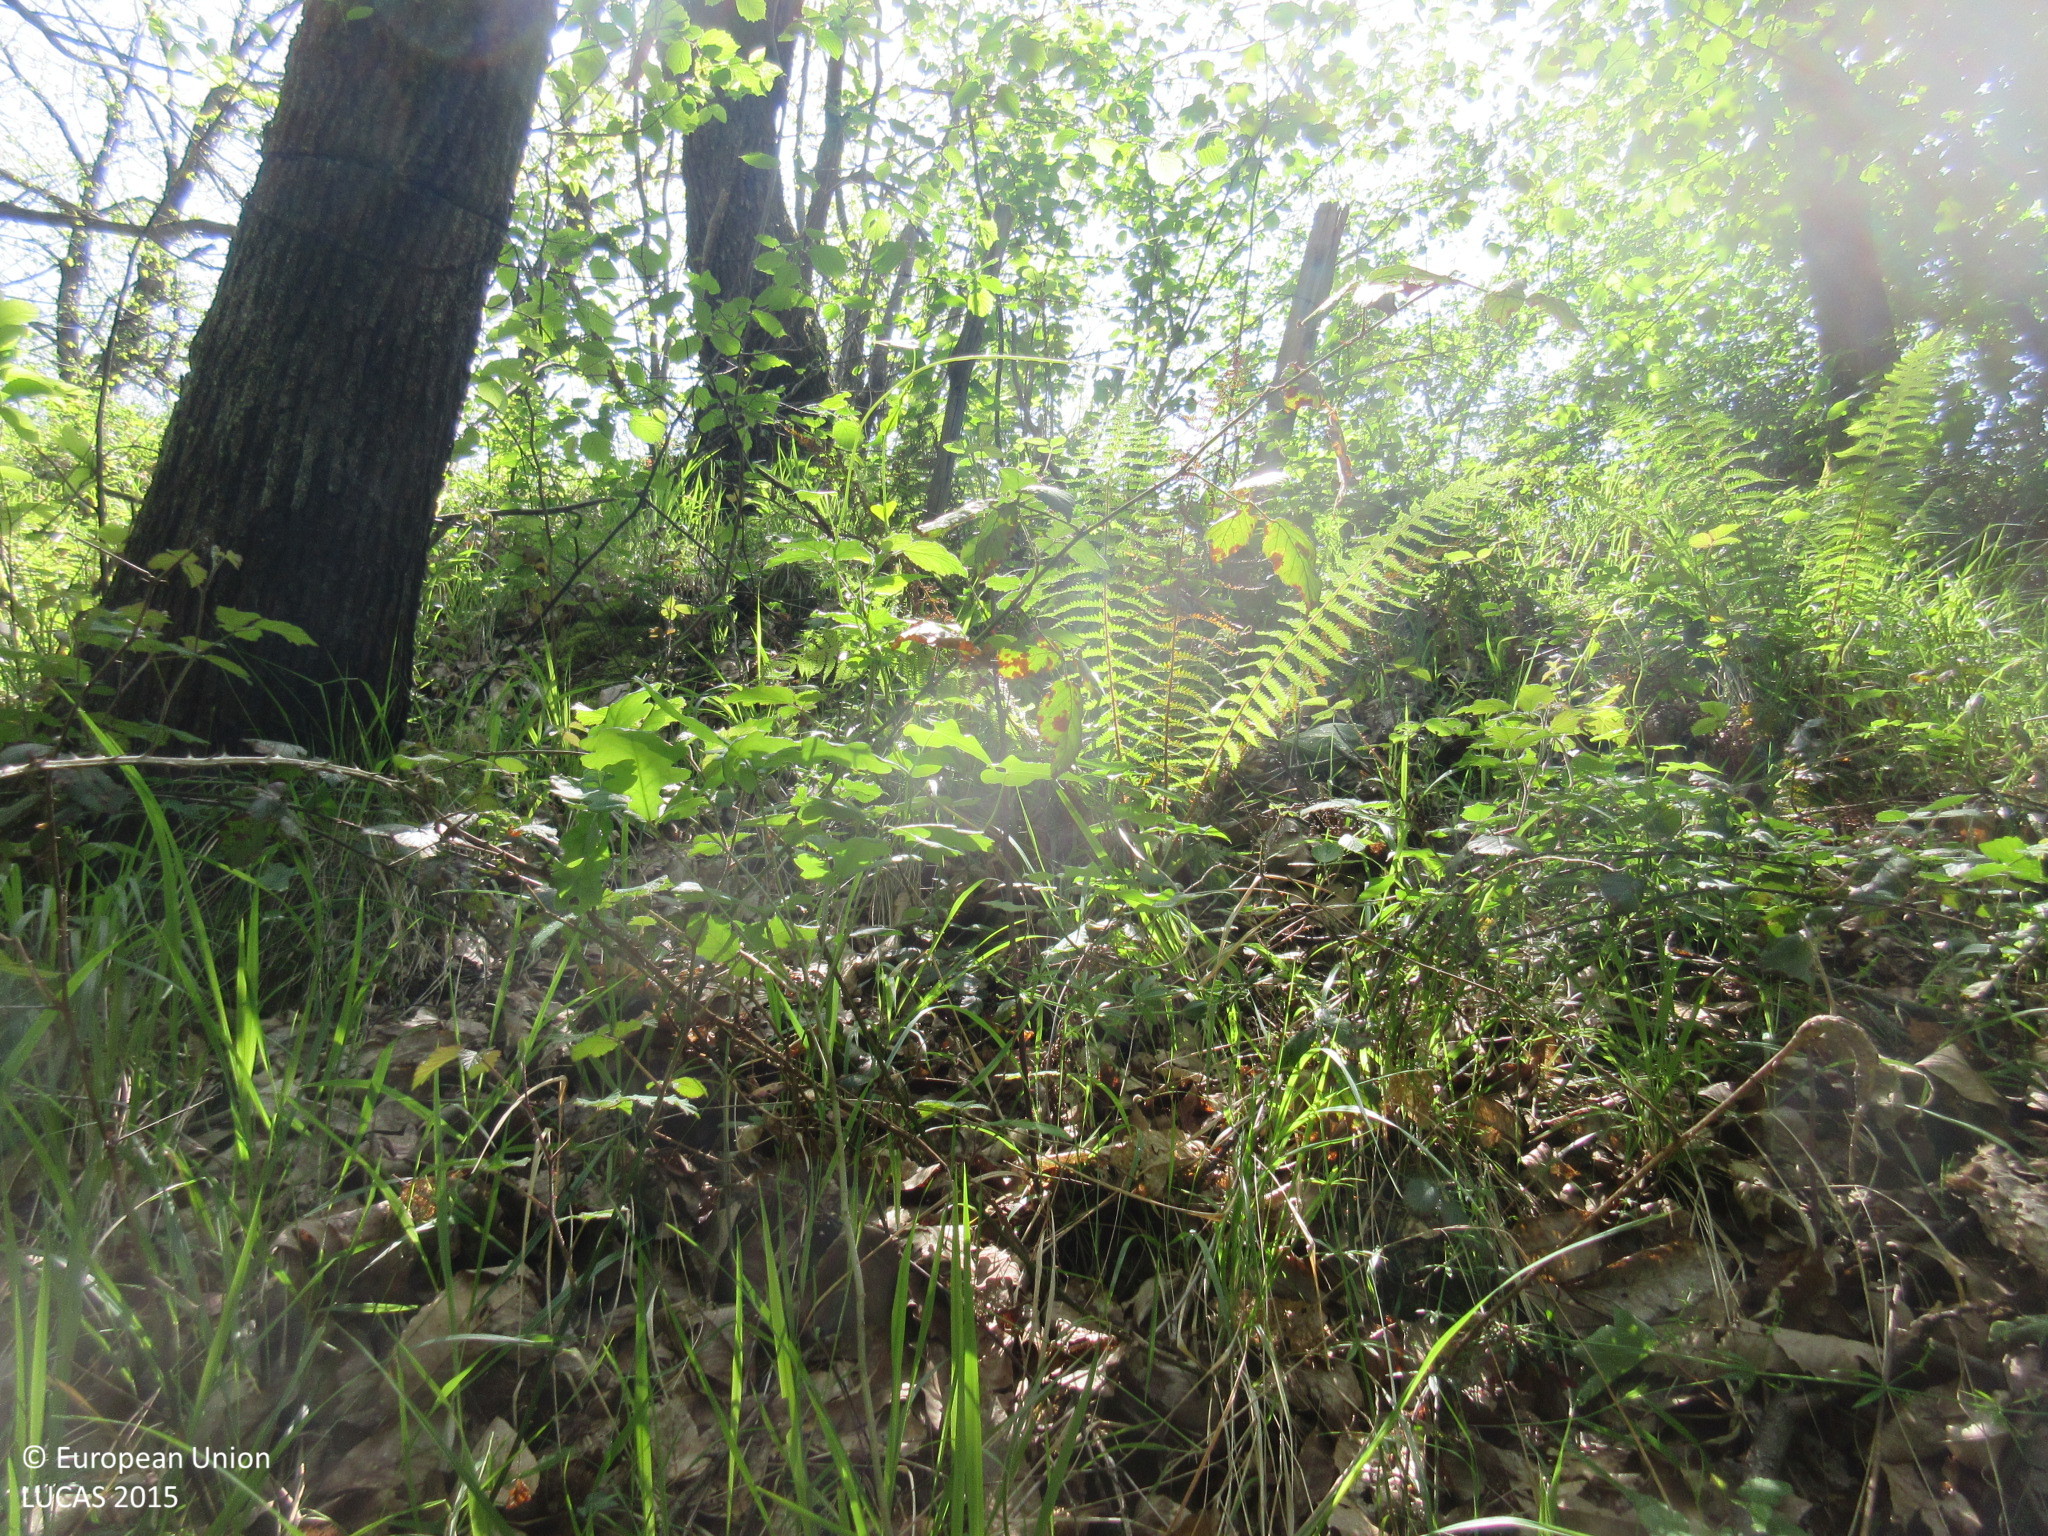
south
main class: Woodland
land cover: Broadleaved woodland
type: thermophilous deciduous forest
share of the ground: > 75 %
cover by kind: broadleaved forest trees 100 %
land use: Semi-natural and natural areas not in use
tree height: > 5 m
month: May
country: ES
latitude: 43.3058
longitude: -5.8548
